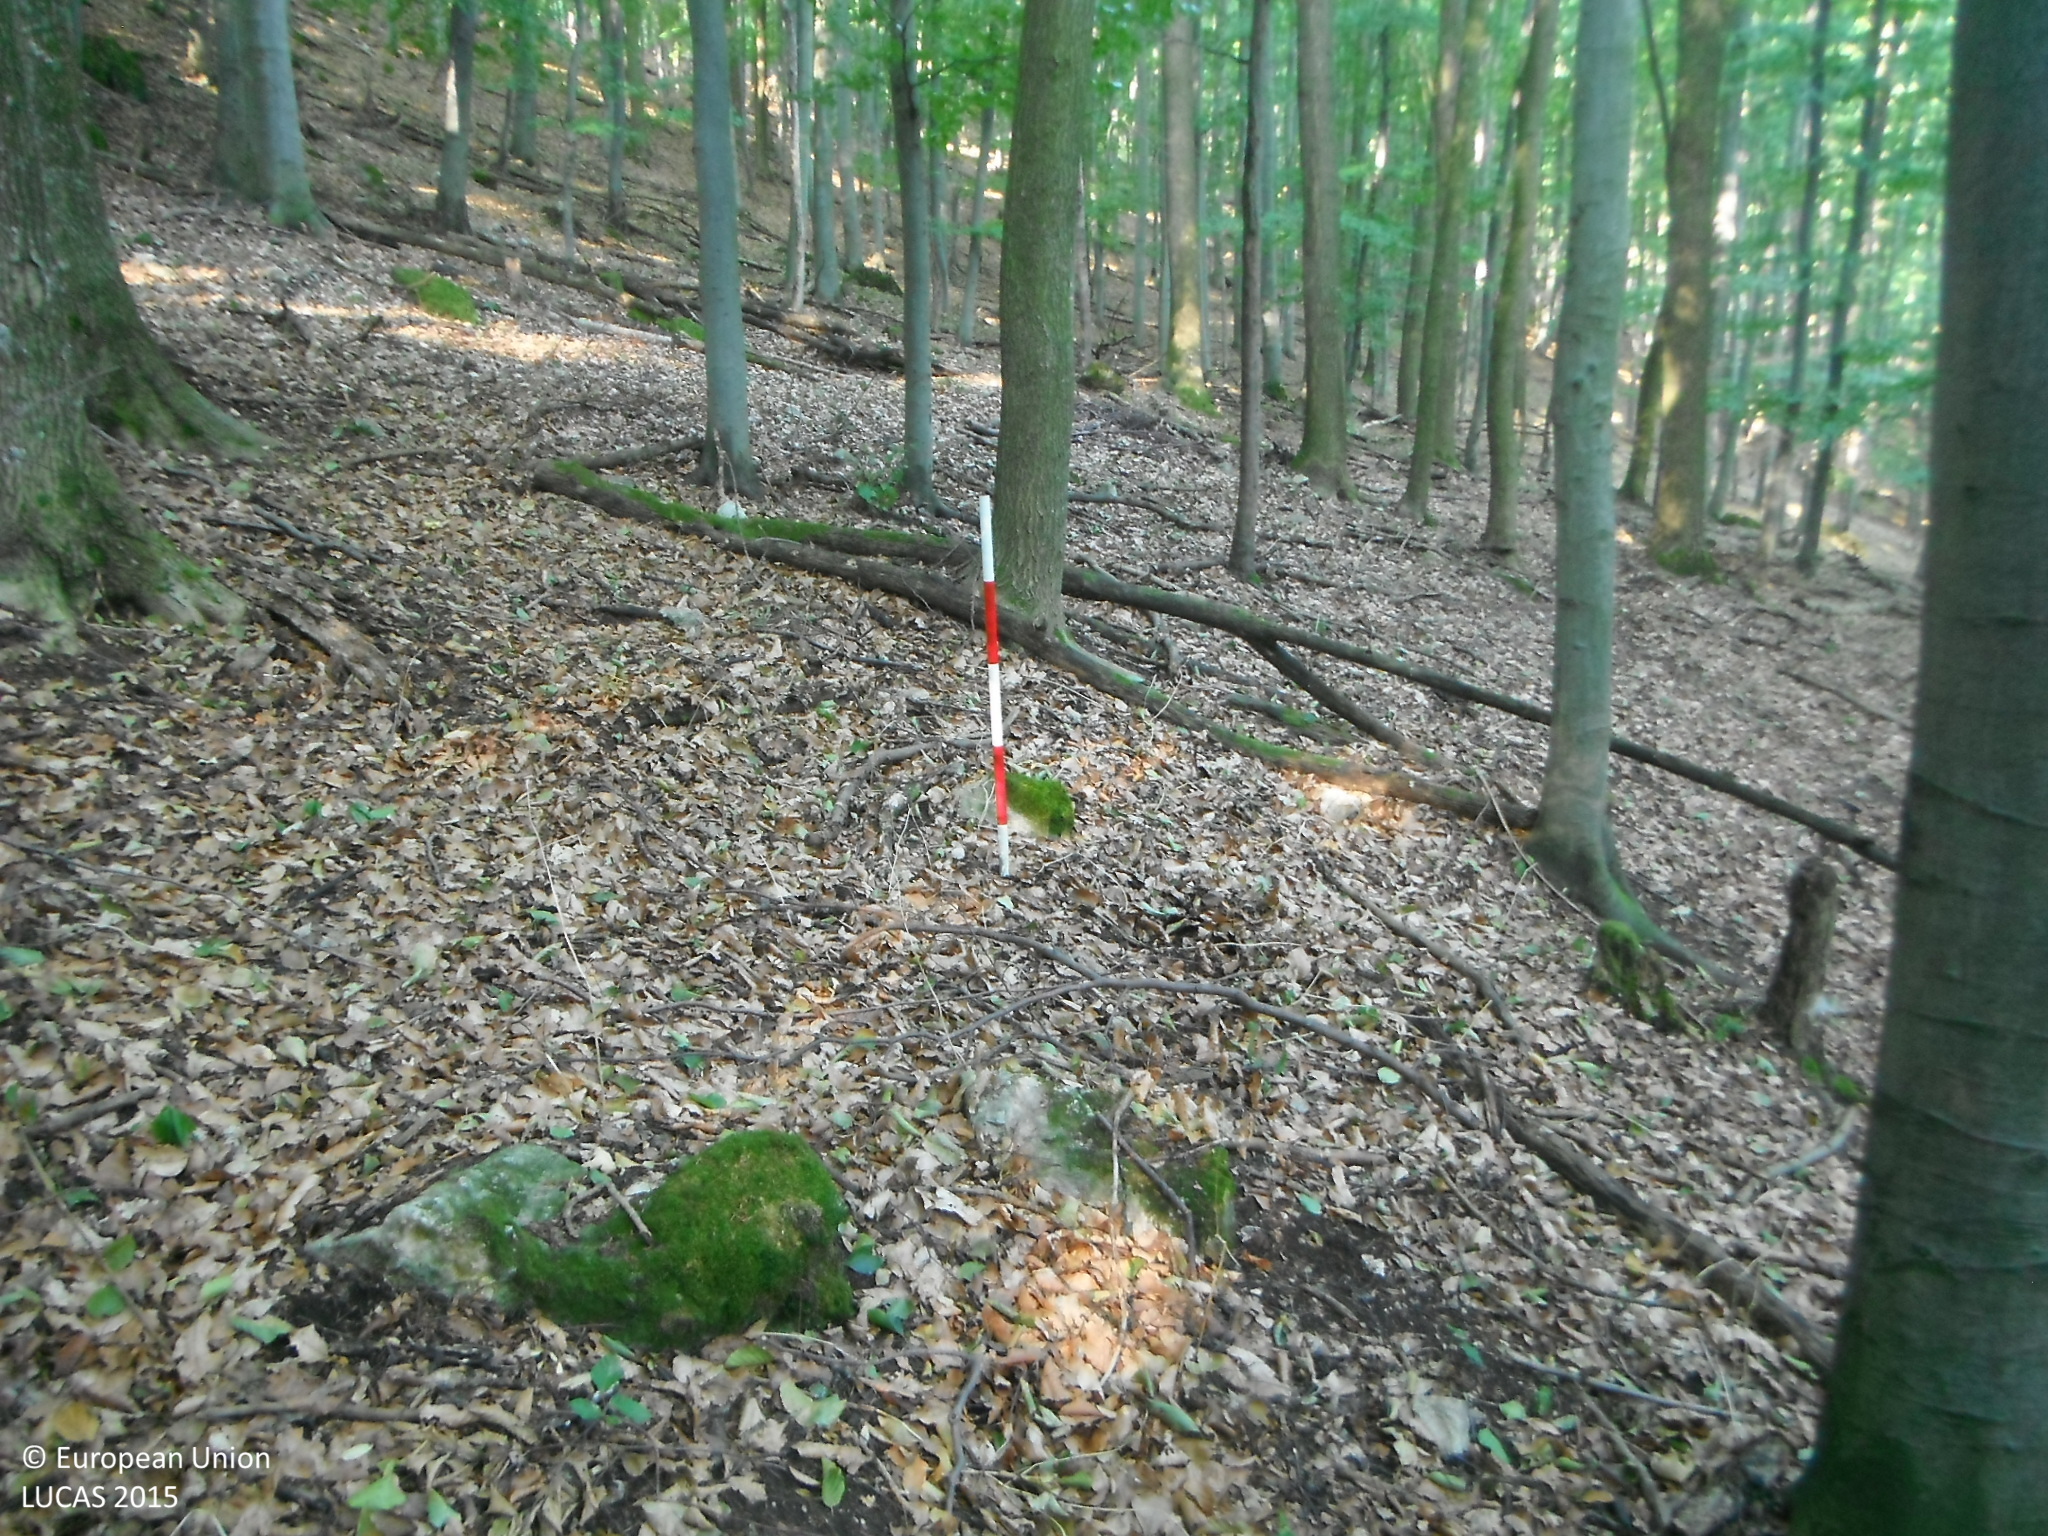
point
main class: Woodland
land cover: Broadleaved woodland
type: beech forest
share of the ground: > 75 %
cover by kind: broadleaved forest trees 95 %, consolidated bare surface 5 %
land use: Forestry
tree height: > 5 m
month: August
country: SK
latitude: 48.6053
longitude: 17.9471
